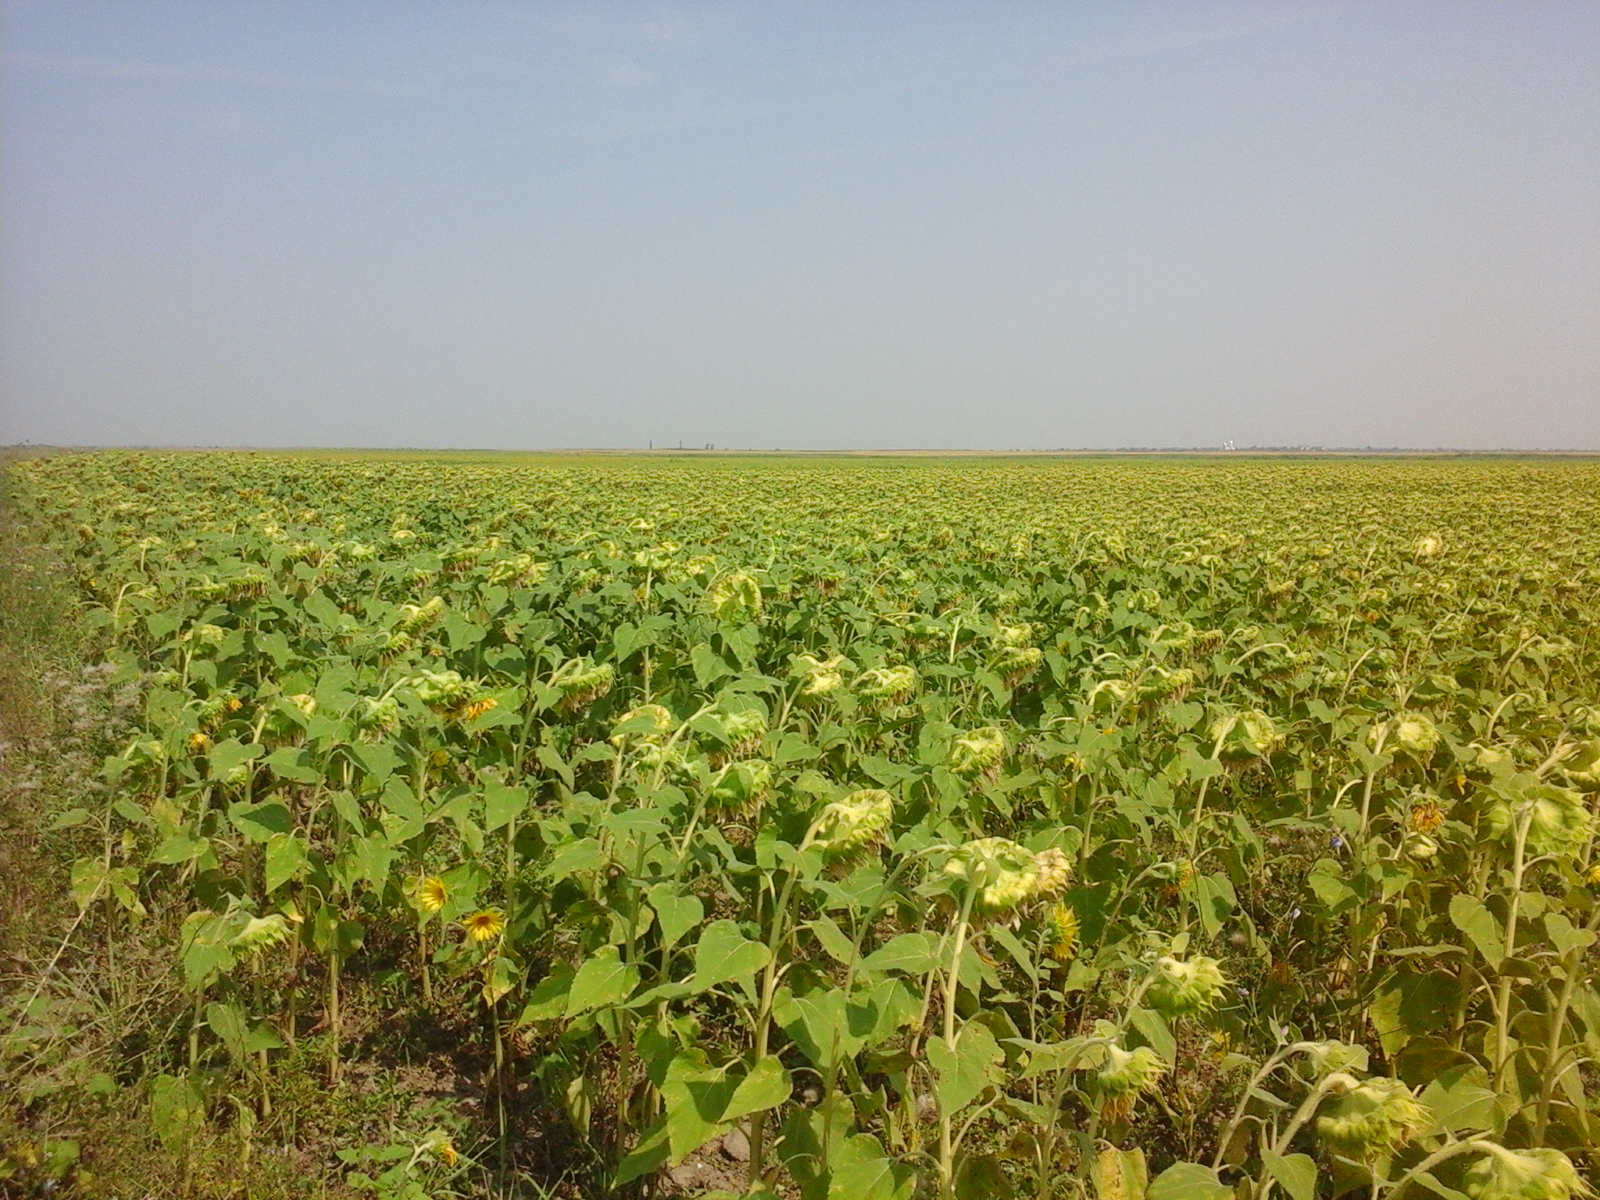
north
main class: Cropland
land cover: Sunflower
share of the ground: > 75 %
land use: Agriculture (excluding fallow land and kitchen gardens)
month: August
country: RO
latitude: 43.8851
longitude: 23.3515
